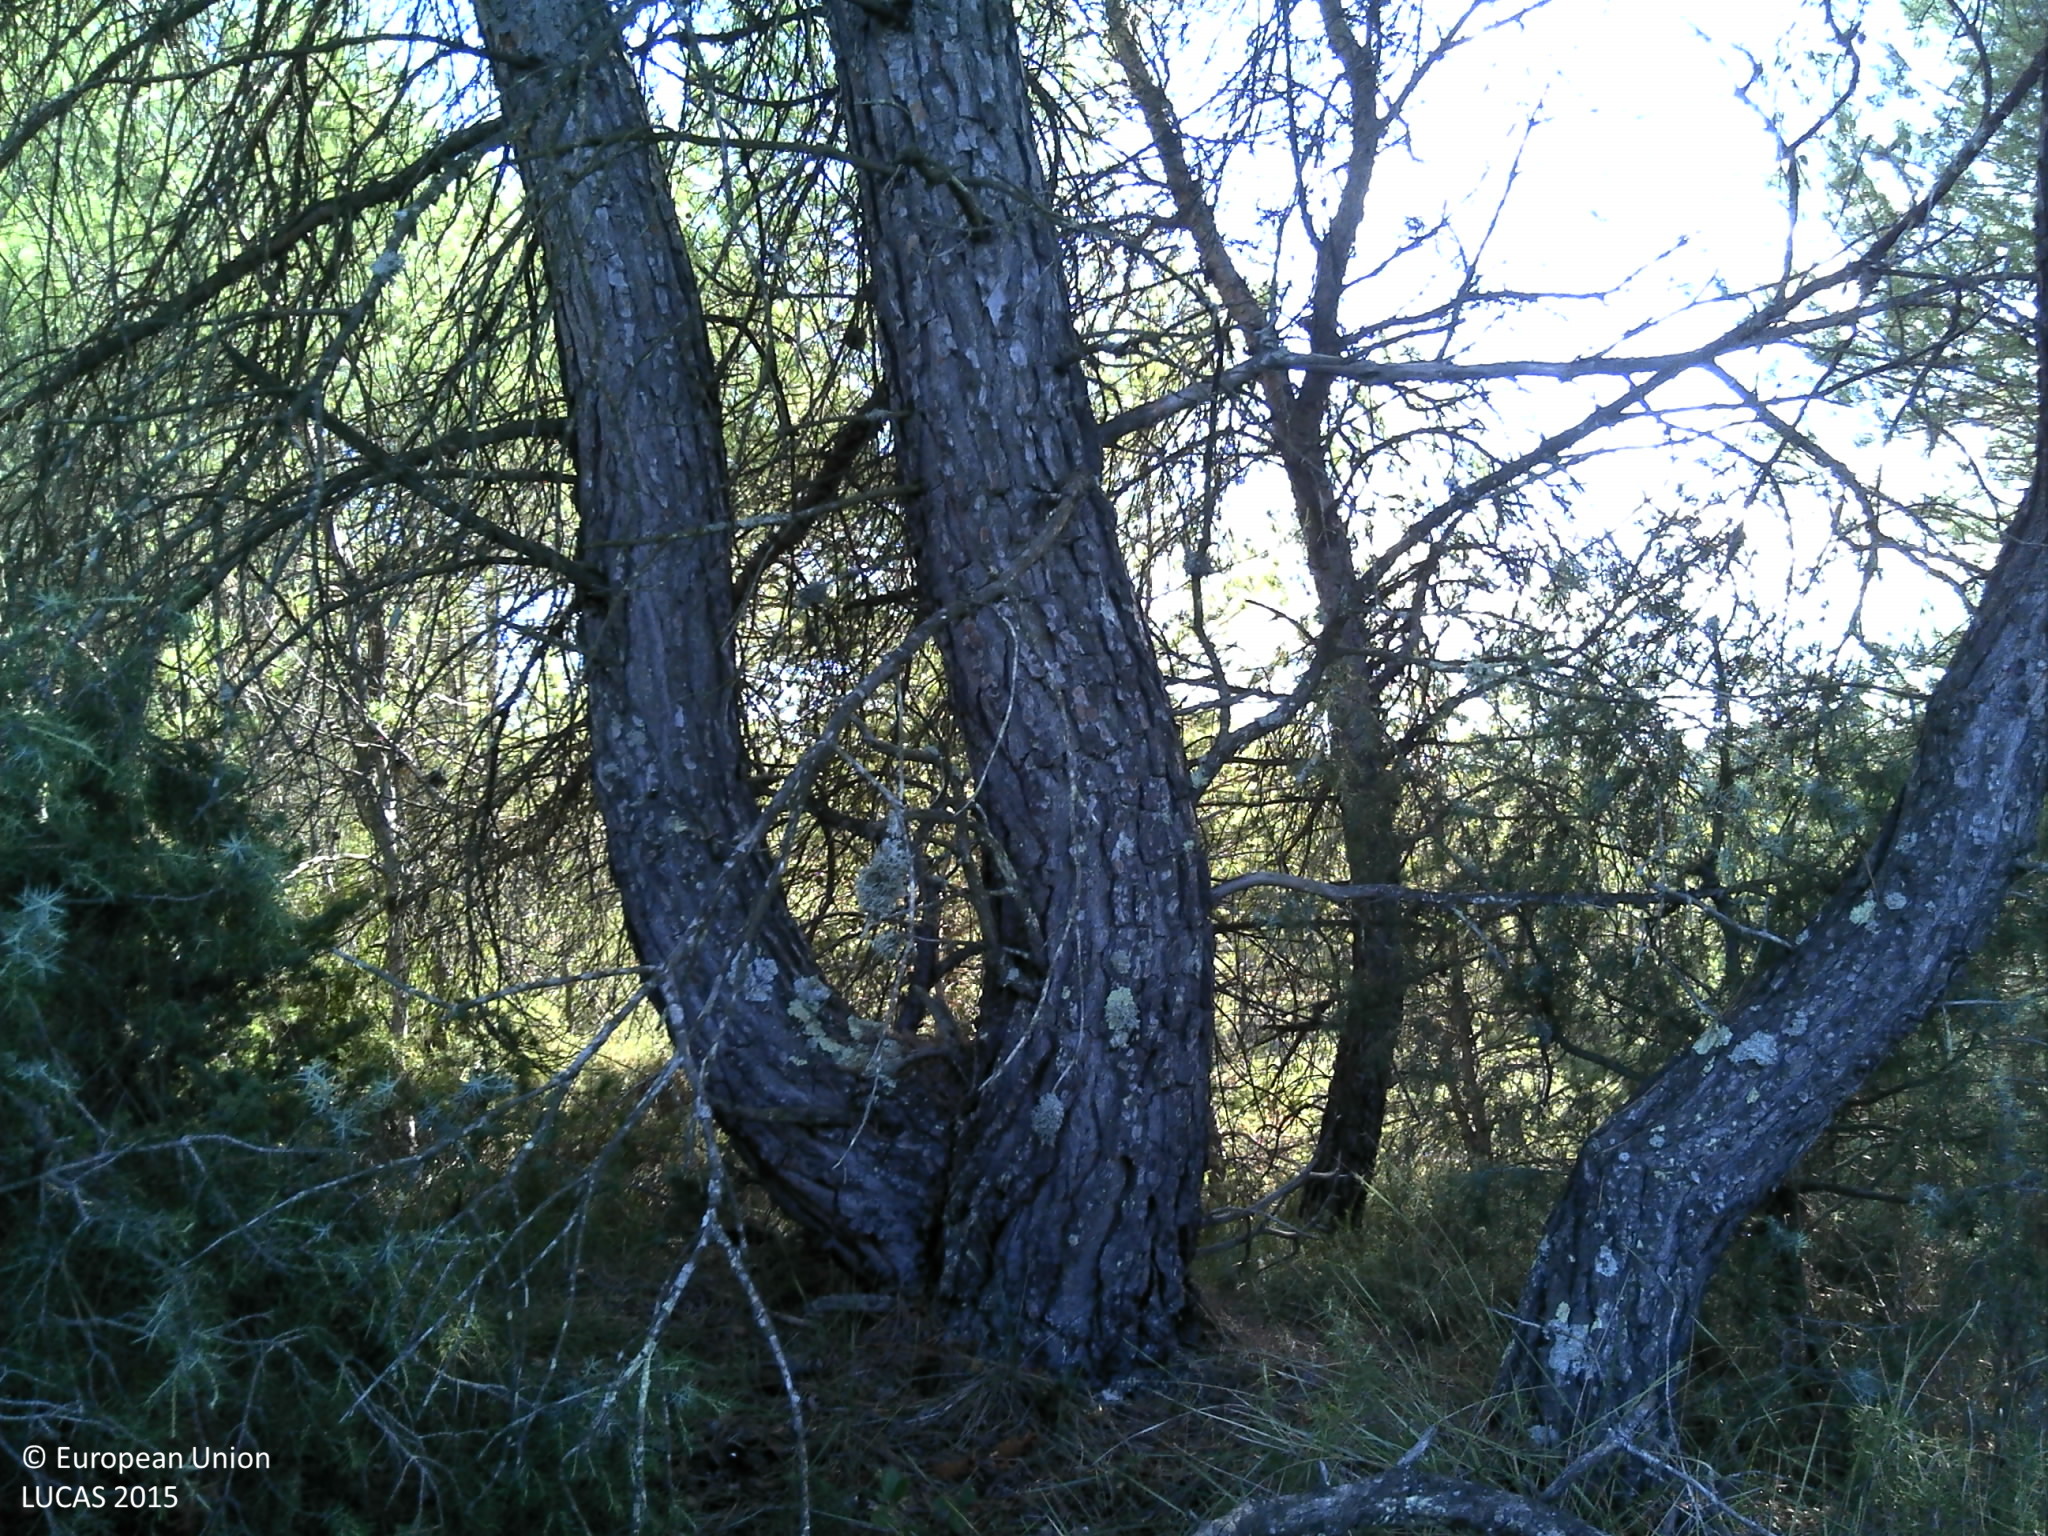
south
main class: Woodland
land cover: Pine dominated mixed woodland
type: coniferous forest of the mediterranean region
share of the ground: 50 - 75 %
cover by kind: coniferous forest trees 50 %, broadleaved forest trees 25 %, shrubs 20 %, herbaceous plants 5 %
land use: Forestry
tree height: > 5 m
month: September
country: FR
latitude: 43.8801
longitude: 5.2420
